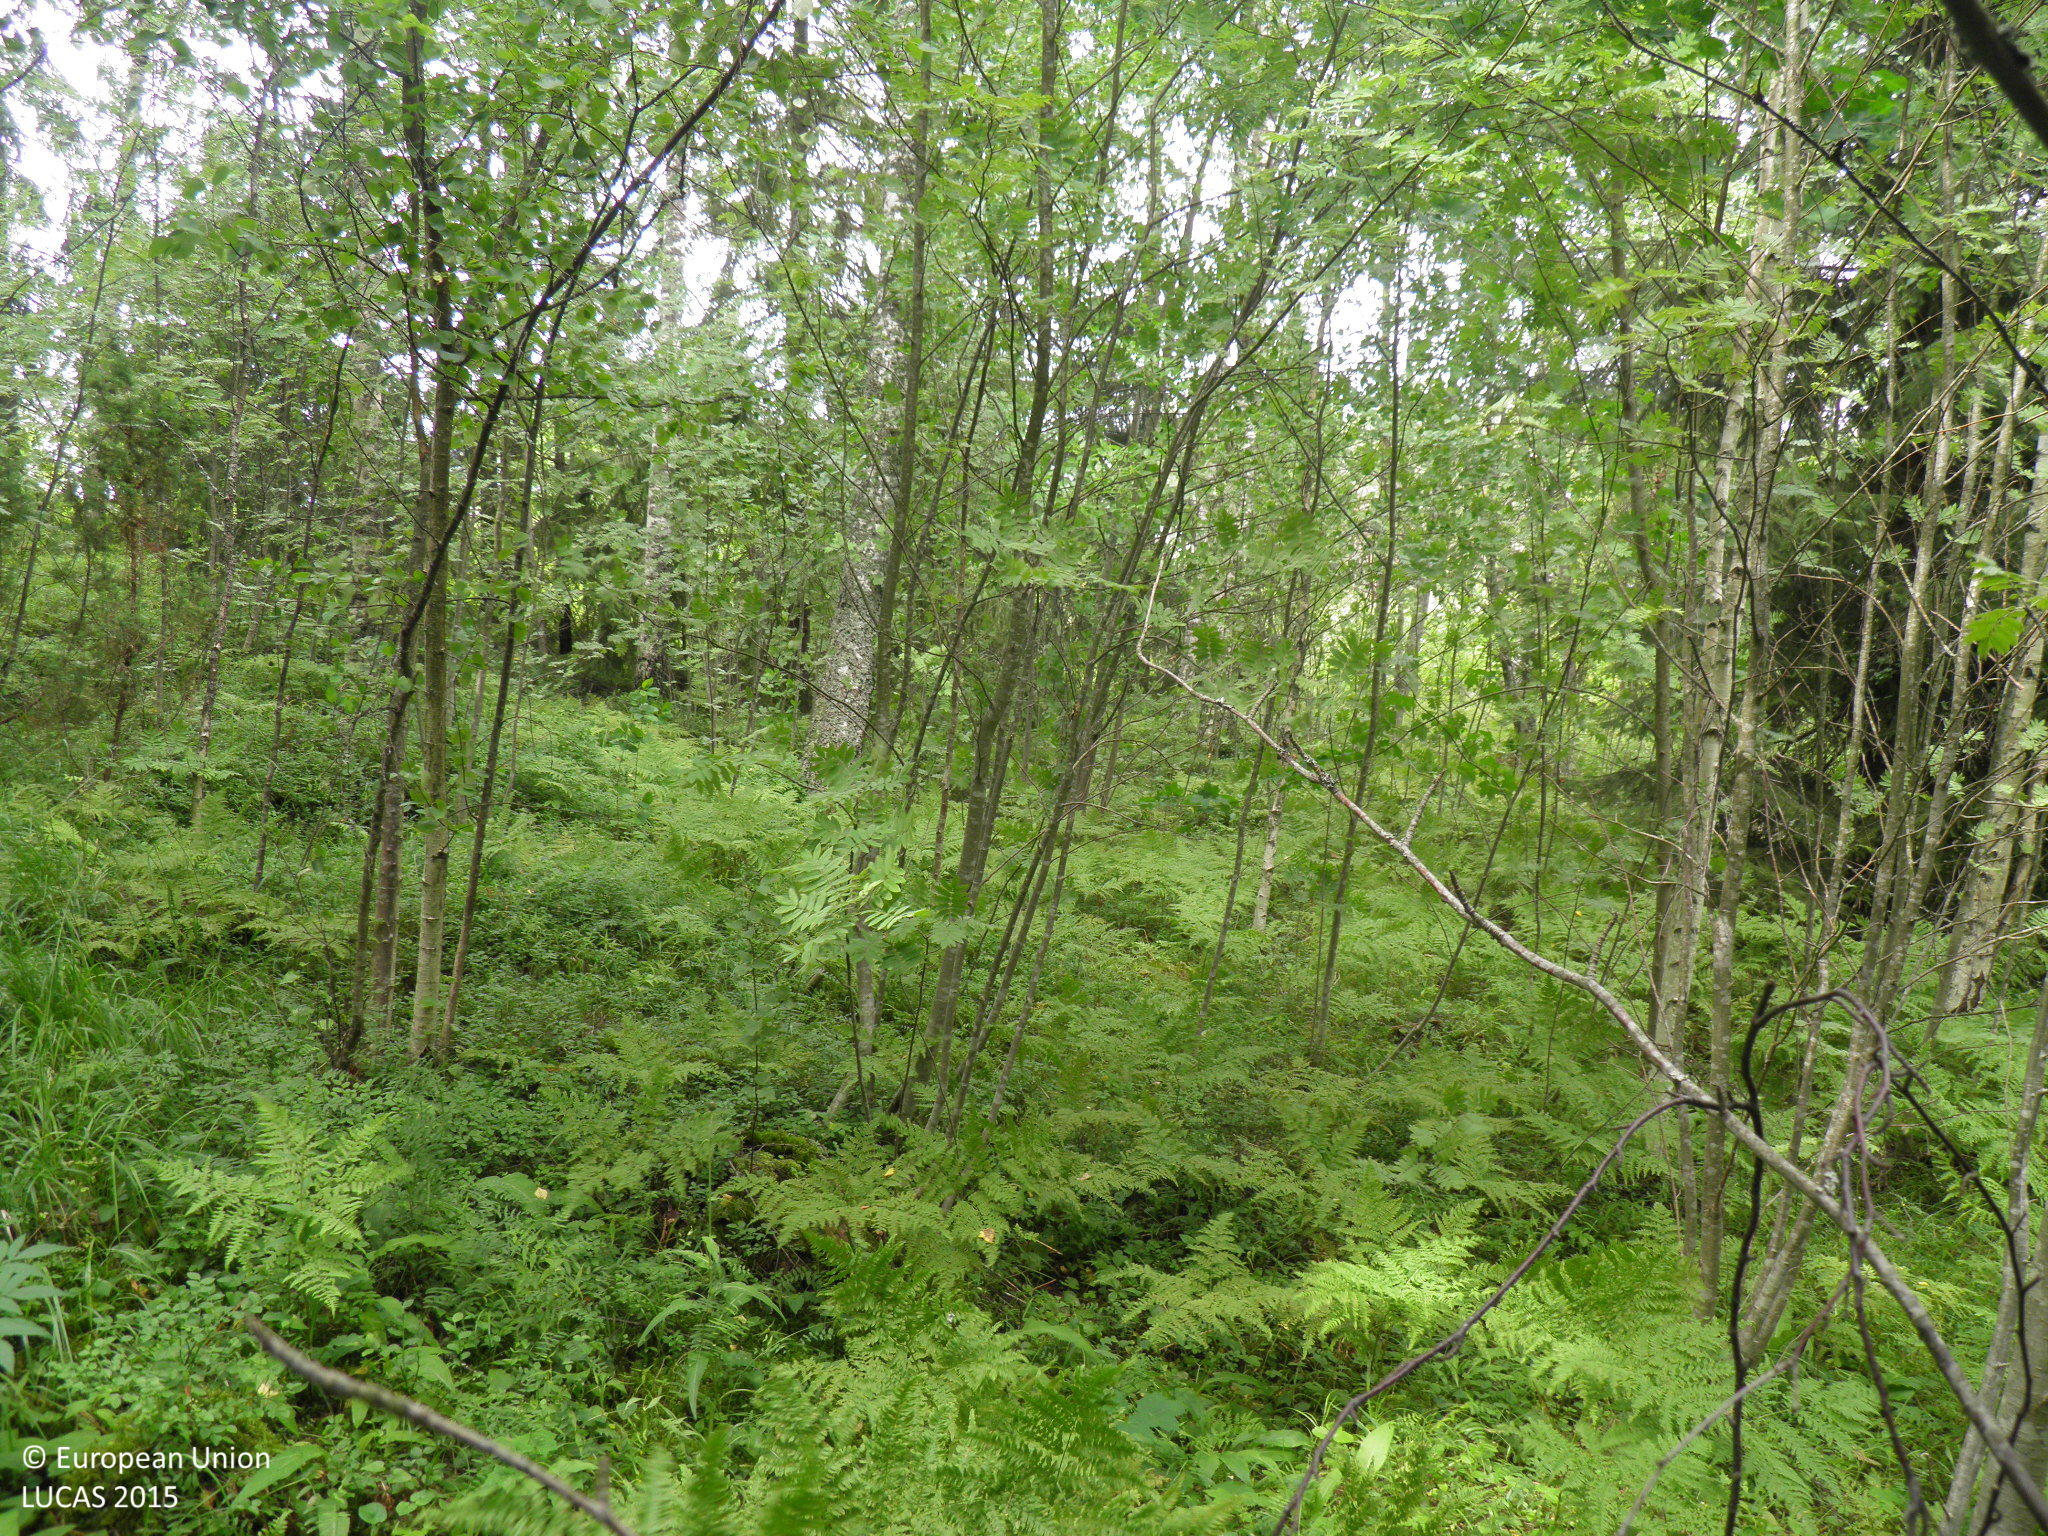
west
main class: Woodland
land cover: Pine dominated mixed woodland
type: hemiboreal forest and nemoral coniferous forest and mixed broadleaved-coniferous forest
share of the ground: > 75 %
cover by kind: broadleaved forest trees 60 %, coniferous forest trees 20 %, shrubs 10 %, herbaceous plants 10 %
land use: Residential
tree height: > 5 m
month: July
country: FI
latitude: 60.0646
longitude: 22.4502
